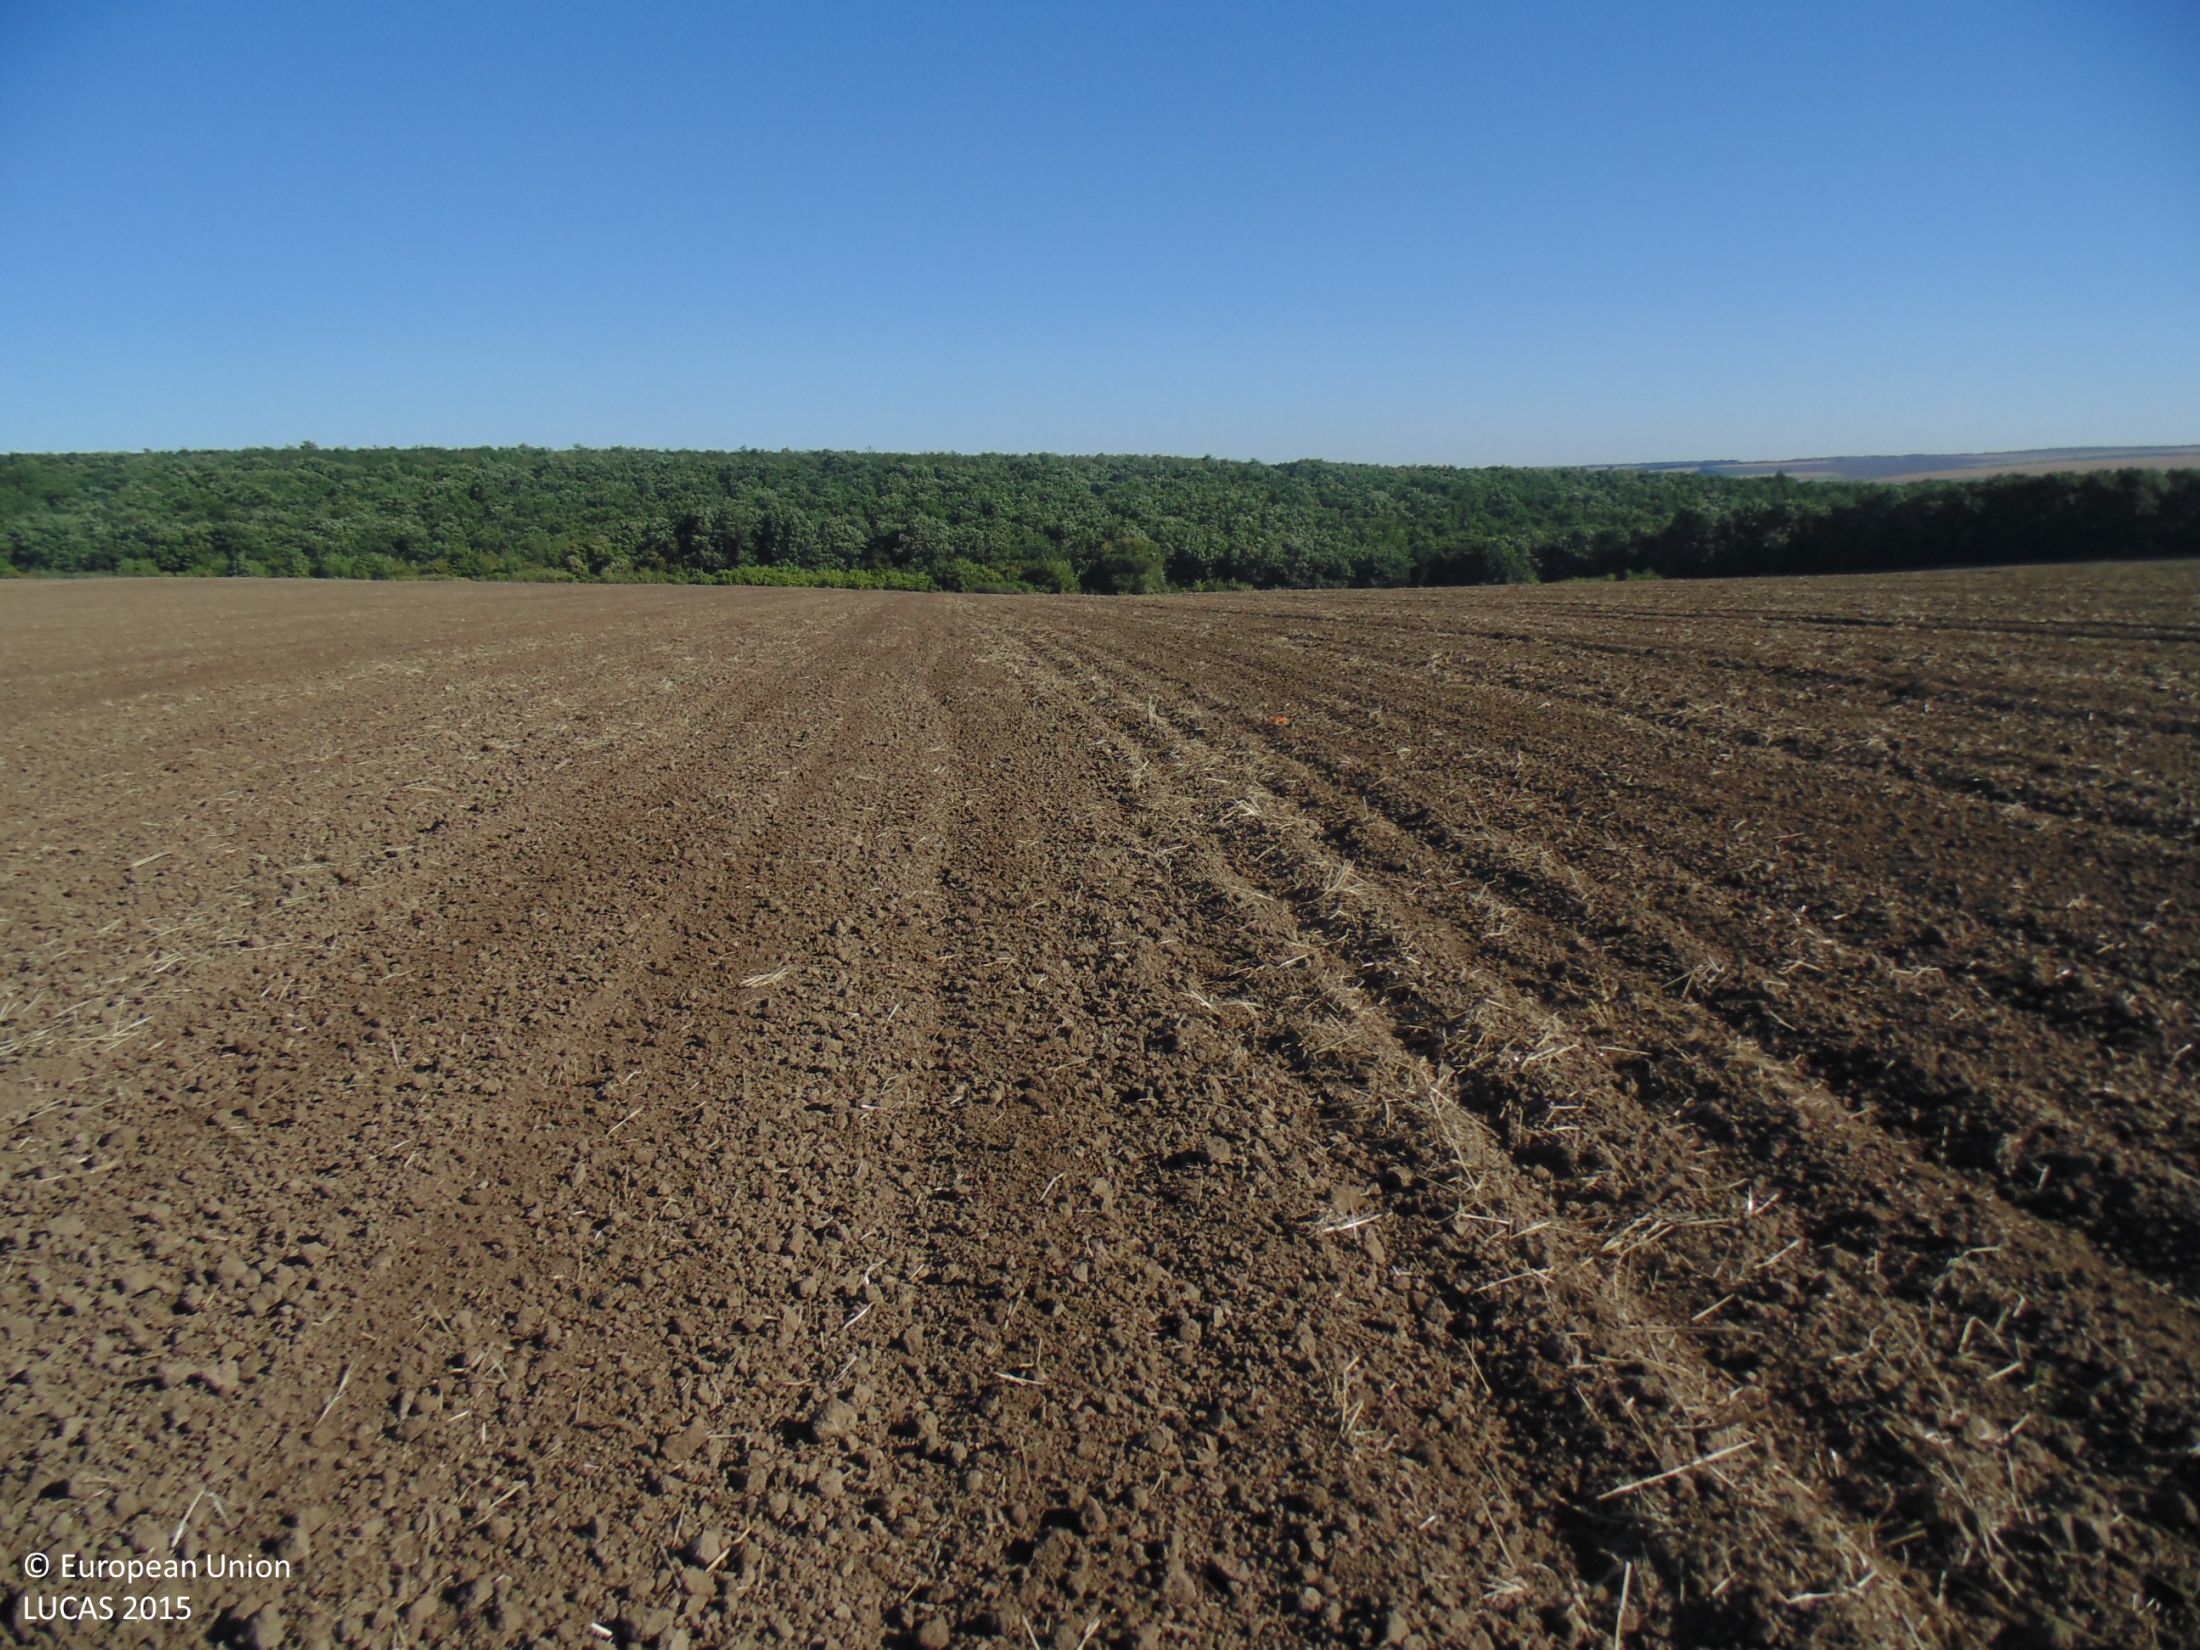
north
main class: Cropland
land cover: Common wheat
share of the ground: < 10 %
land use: Agriculture (excluding fallow land and kitchen gardens)
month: September
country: BG
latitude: 43.7663
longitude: 27.3089
